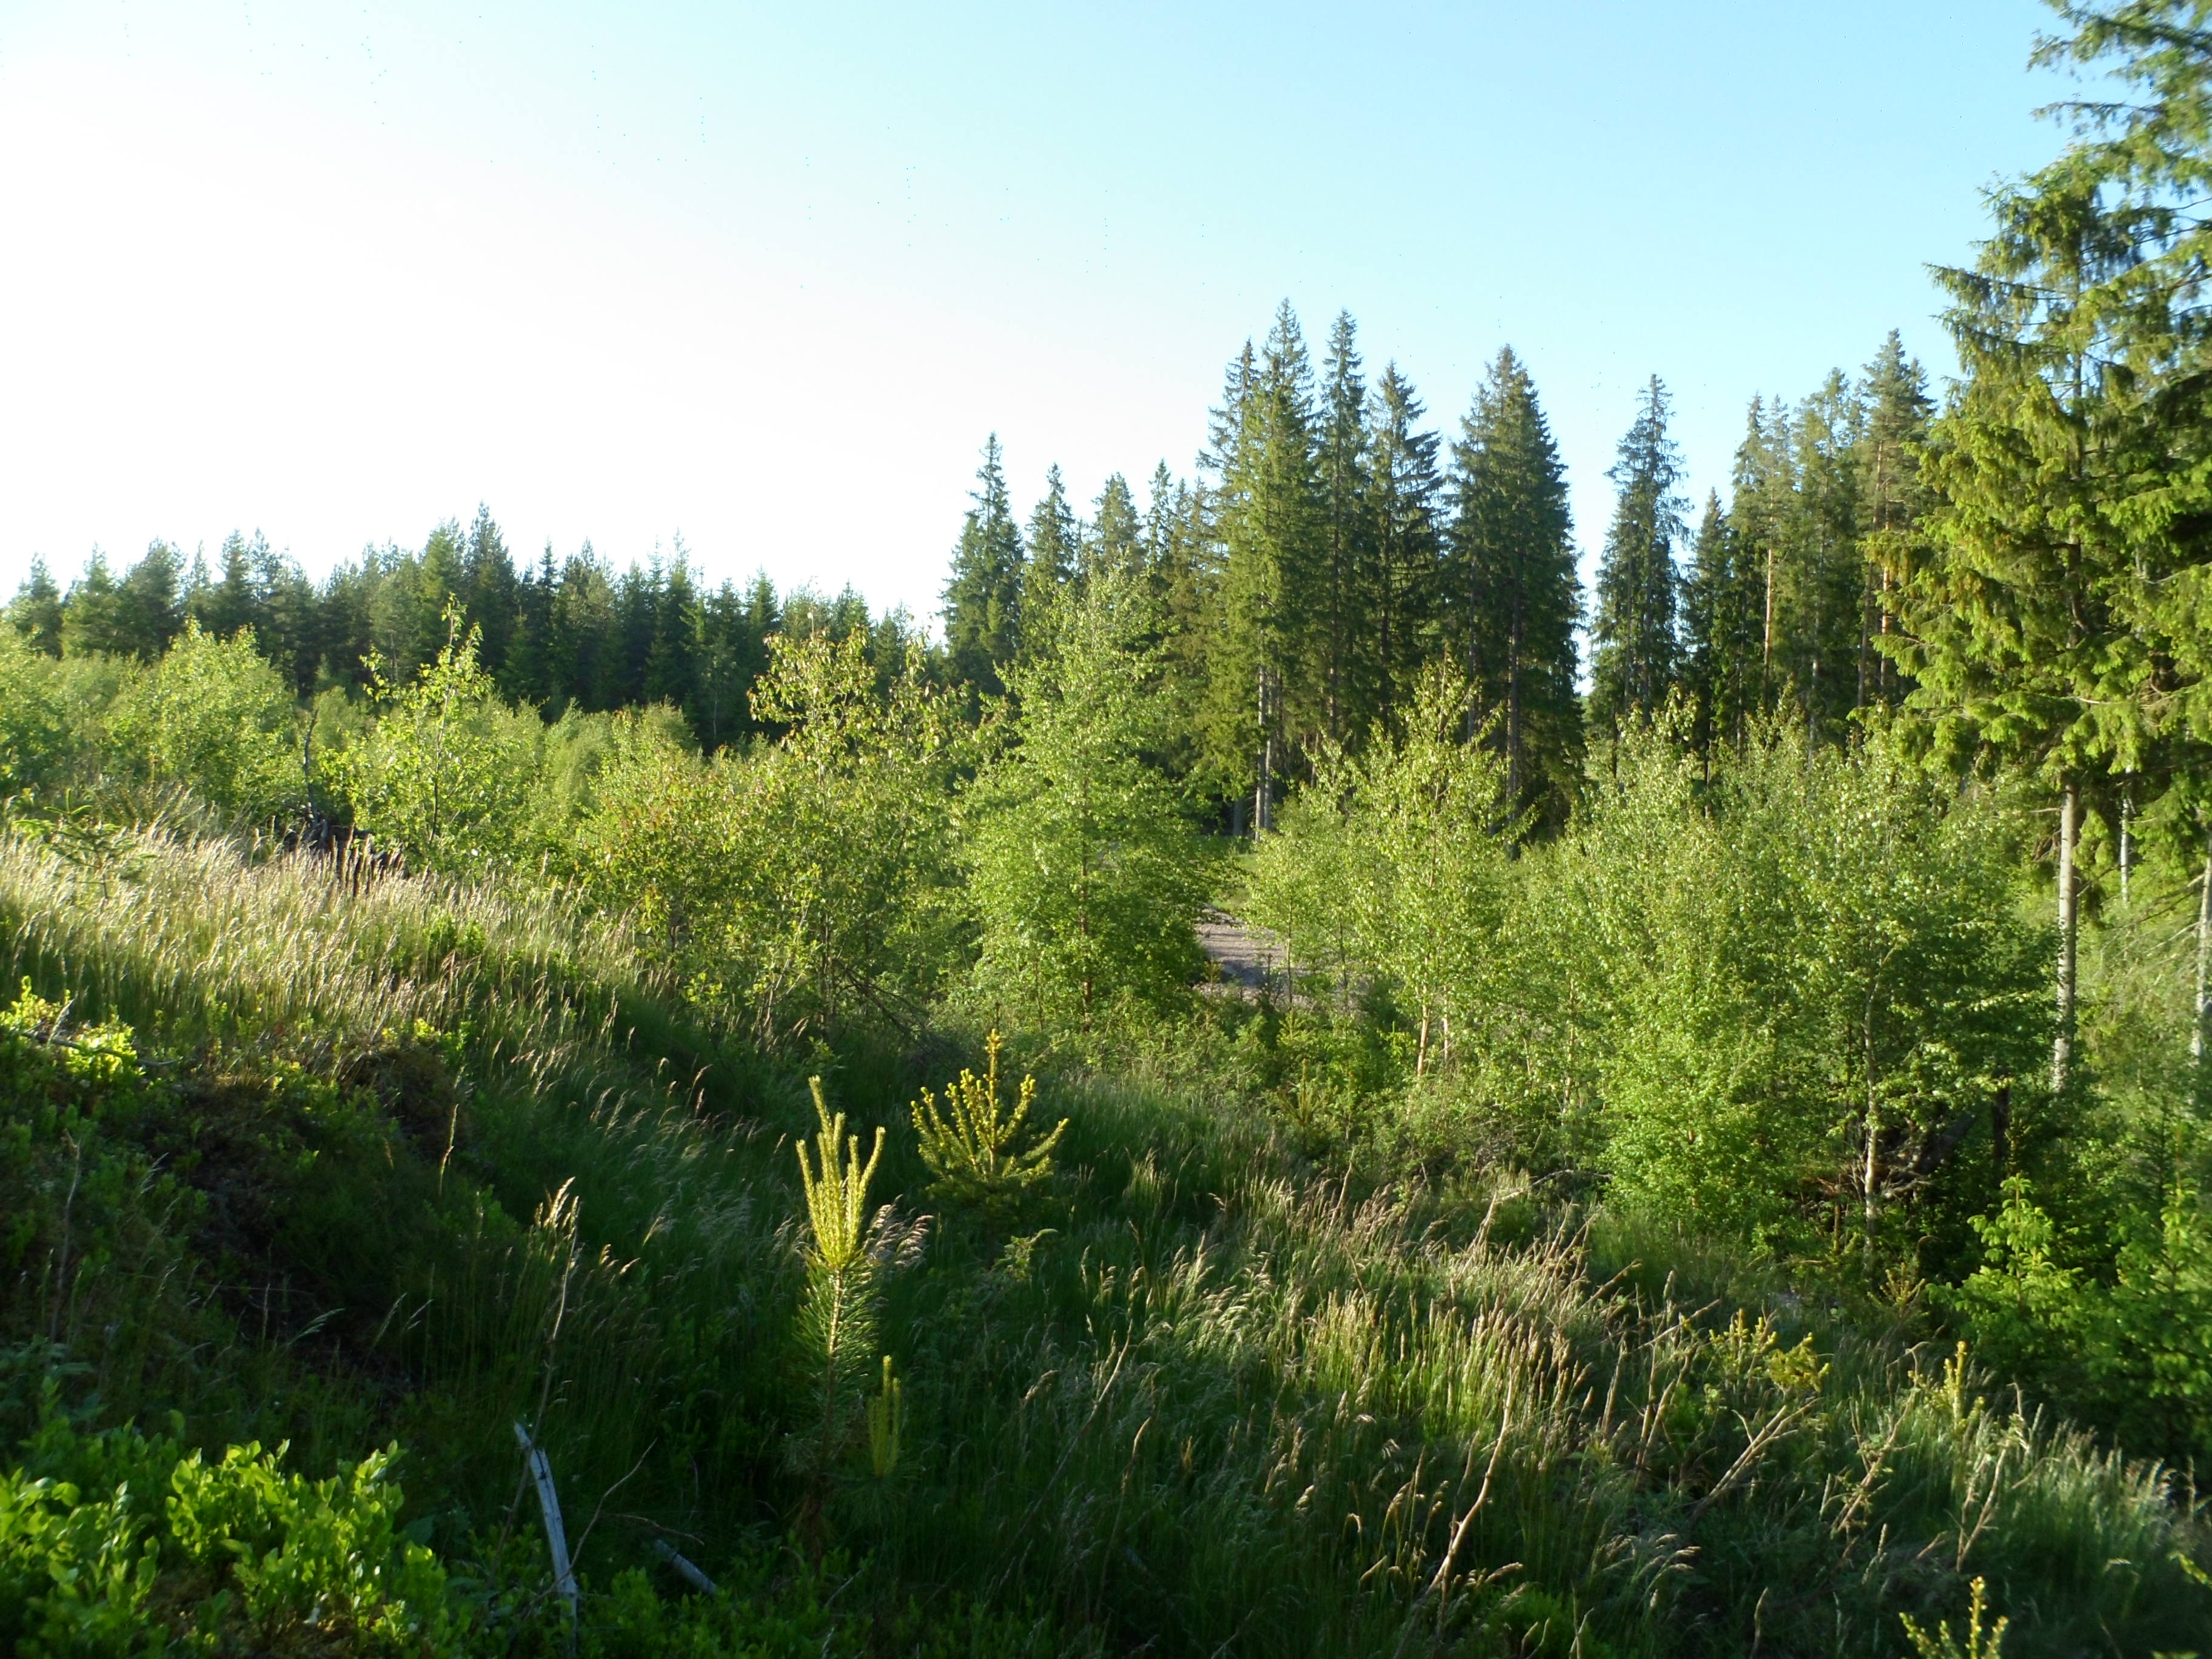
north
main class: Woodland
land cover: Spruce dominated mixed woodland
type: boreal forest
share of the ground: 50 - 75 %
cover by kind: coniferous forest trees 25 %, broadleaved forest trees 25 %, herbaceous plants 25 %, shrubs 20 %, lichens and mosses 5 %
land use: Forestry
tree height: < 5 m
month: June
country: SE
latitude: 57.4701
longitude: 14.1806
